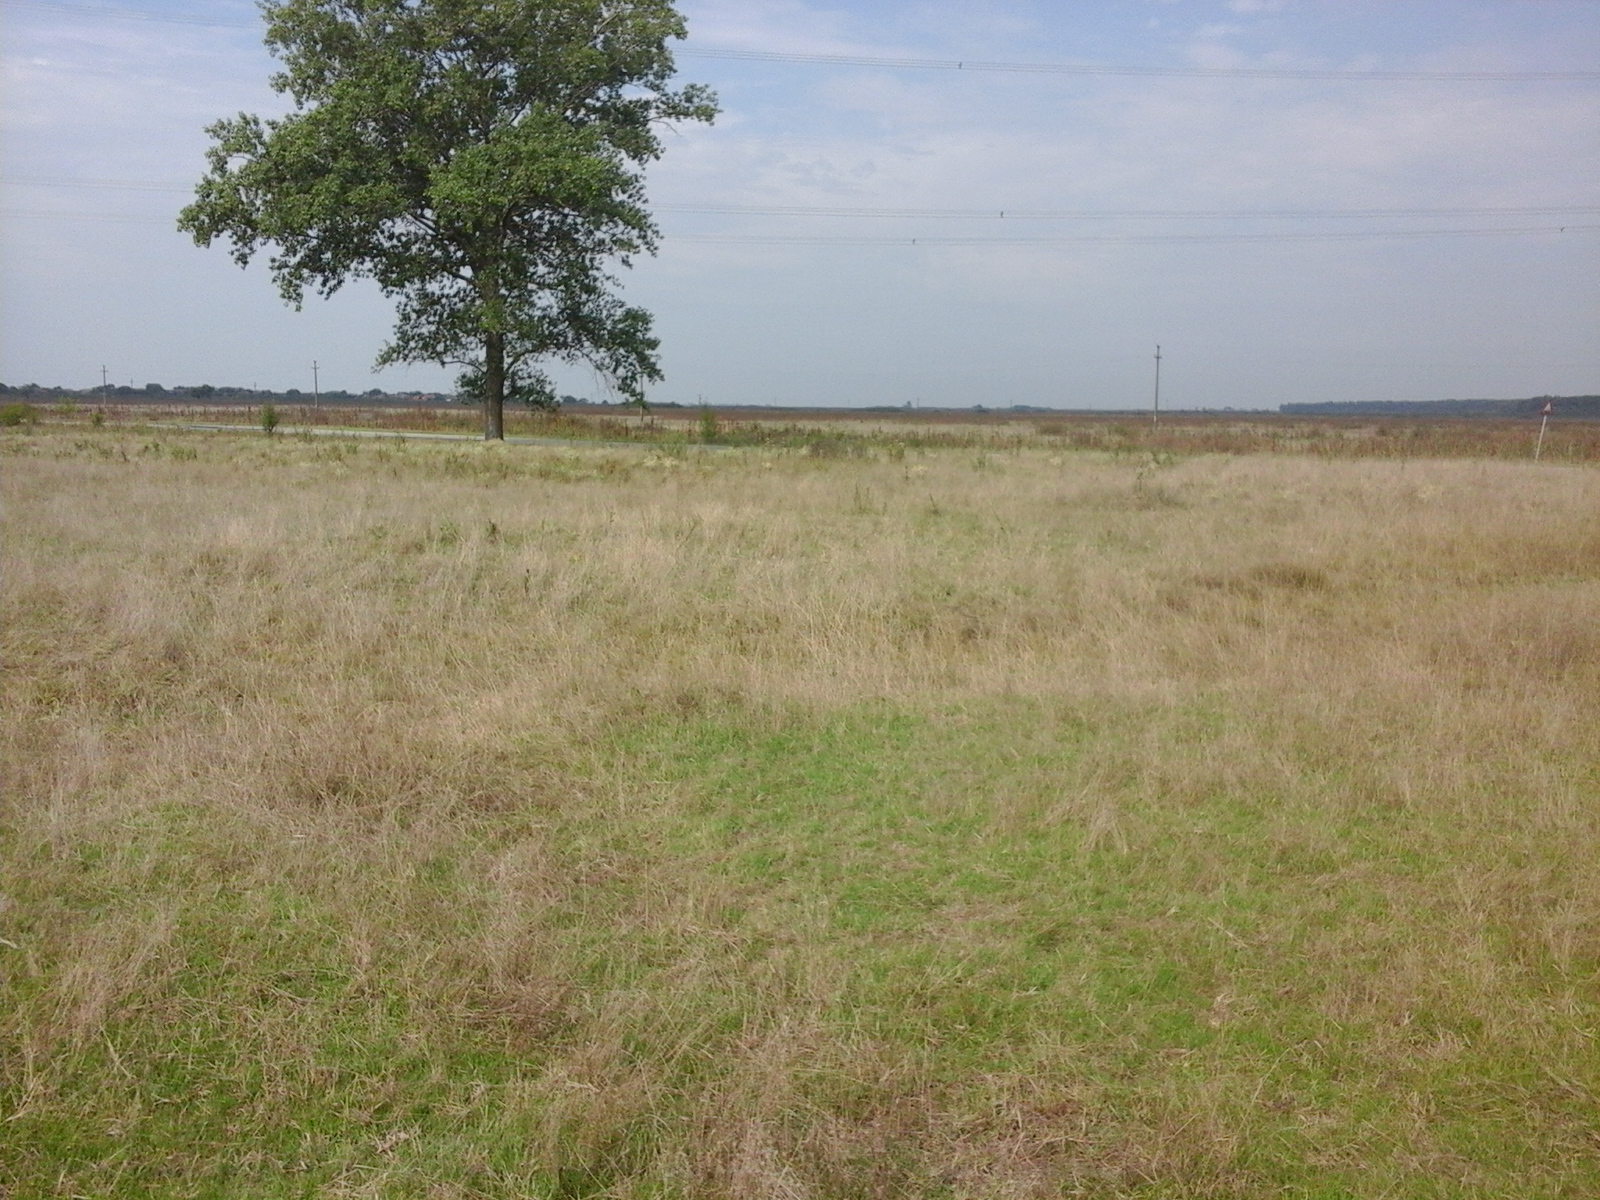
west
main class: Grassland
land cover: Spontaneously vegetated surfaces
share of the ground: > 75 %
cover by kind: herbaceous plants 100 %
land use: Fallow land
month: August
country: RO
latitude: 46.6067
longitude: 21.6204
